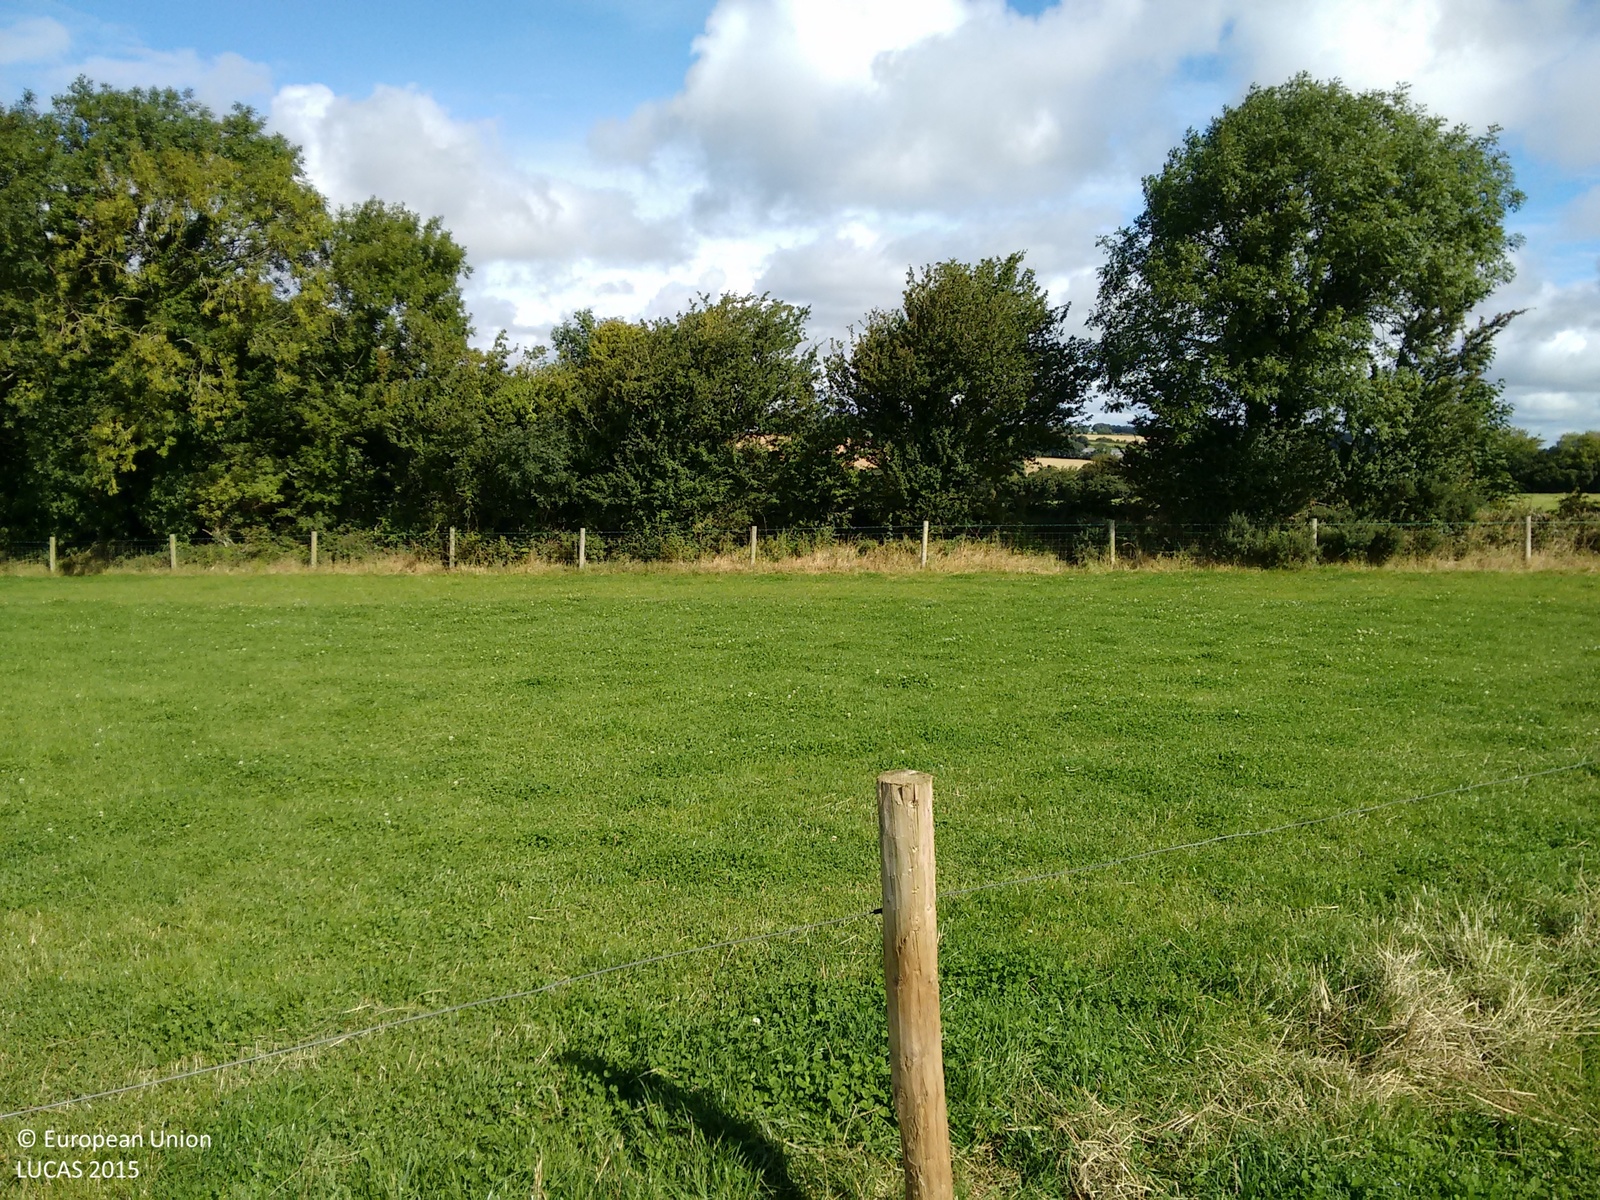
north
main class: Grassland
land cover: Grassland without tree/shrub cover
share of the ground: > 75 %
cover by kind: herbaceous plants 100 %
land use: Agriculture (excluding fallow land and kitchen gardens)
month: August
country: IE
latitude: 52.3868
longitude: -6.6320
